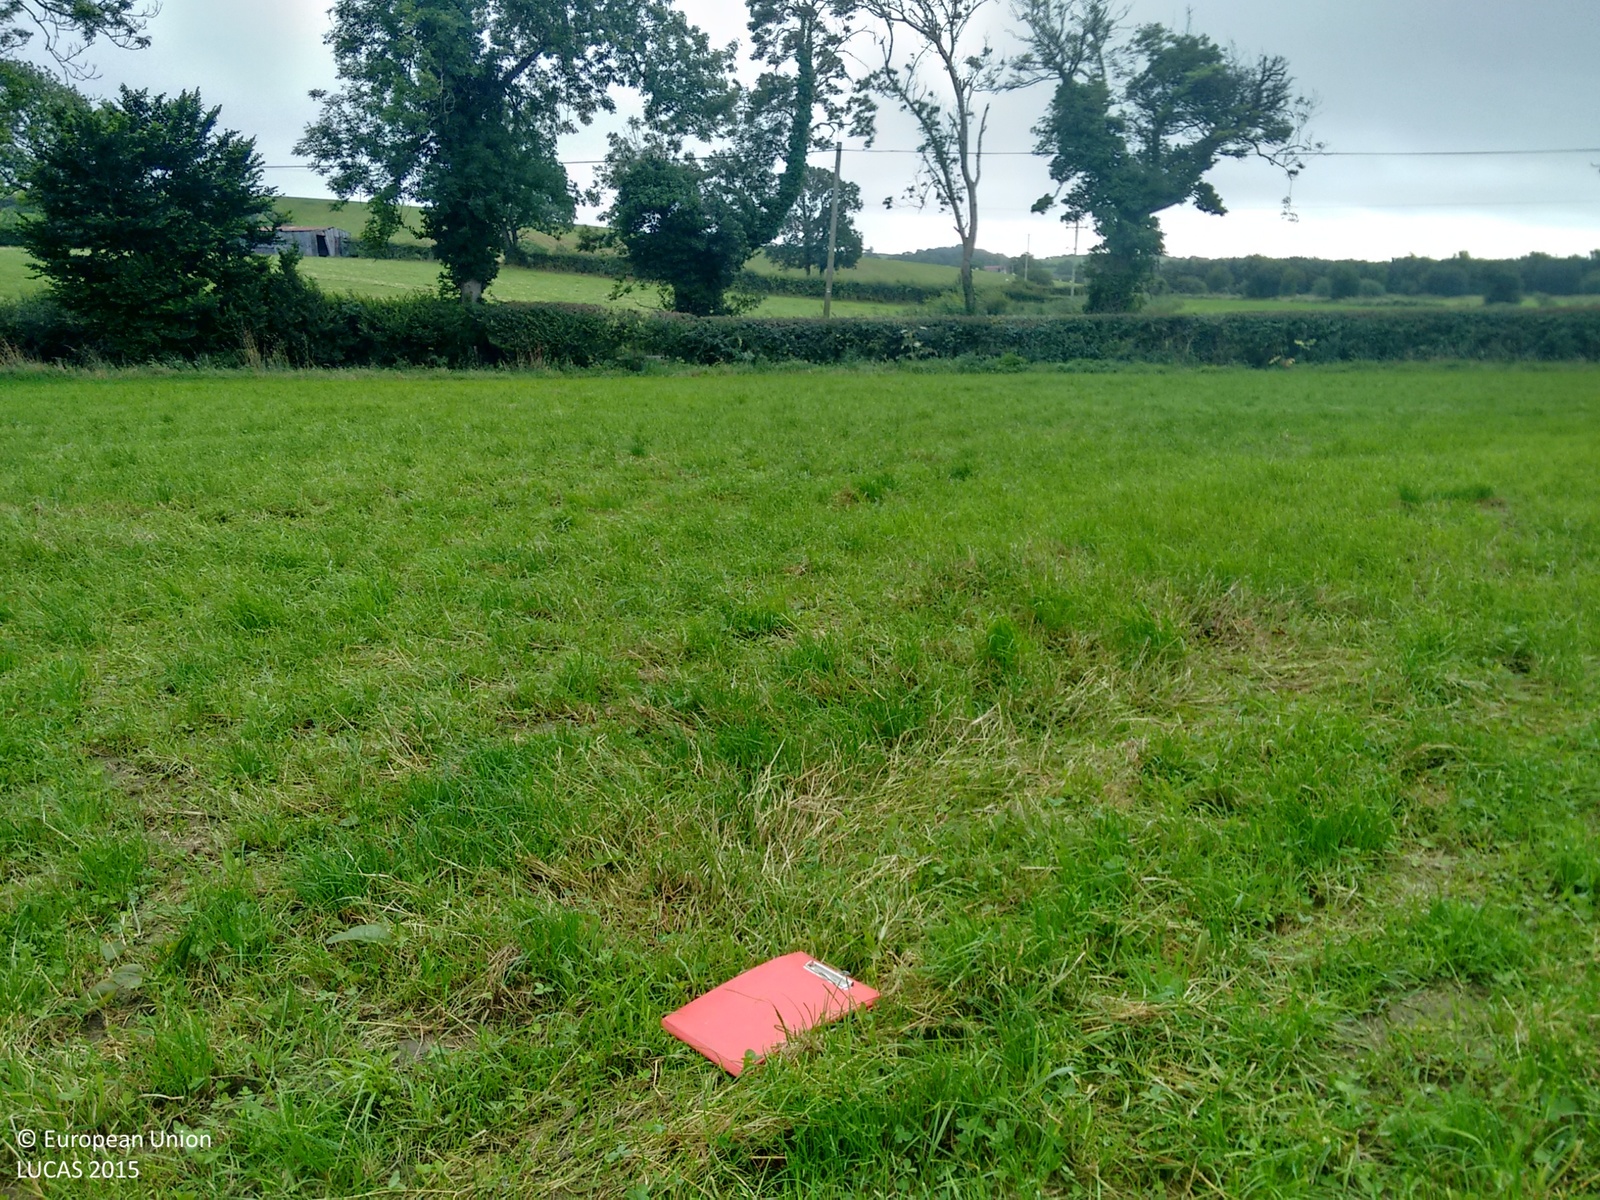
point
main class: Grassland
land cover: Grassland without tree/shrub cover
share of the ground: > 75 %
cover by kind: herbaceous plants 100 %
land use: Agriculture (excluding fallow land and kitchen gardens)
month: August
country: GB
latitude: 54.3571
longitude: -5.7845
